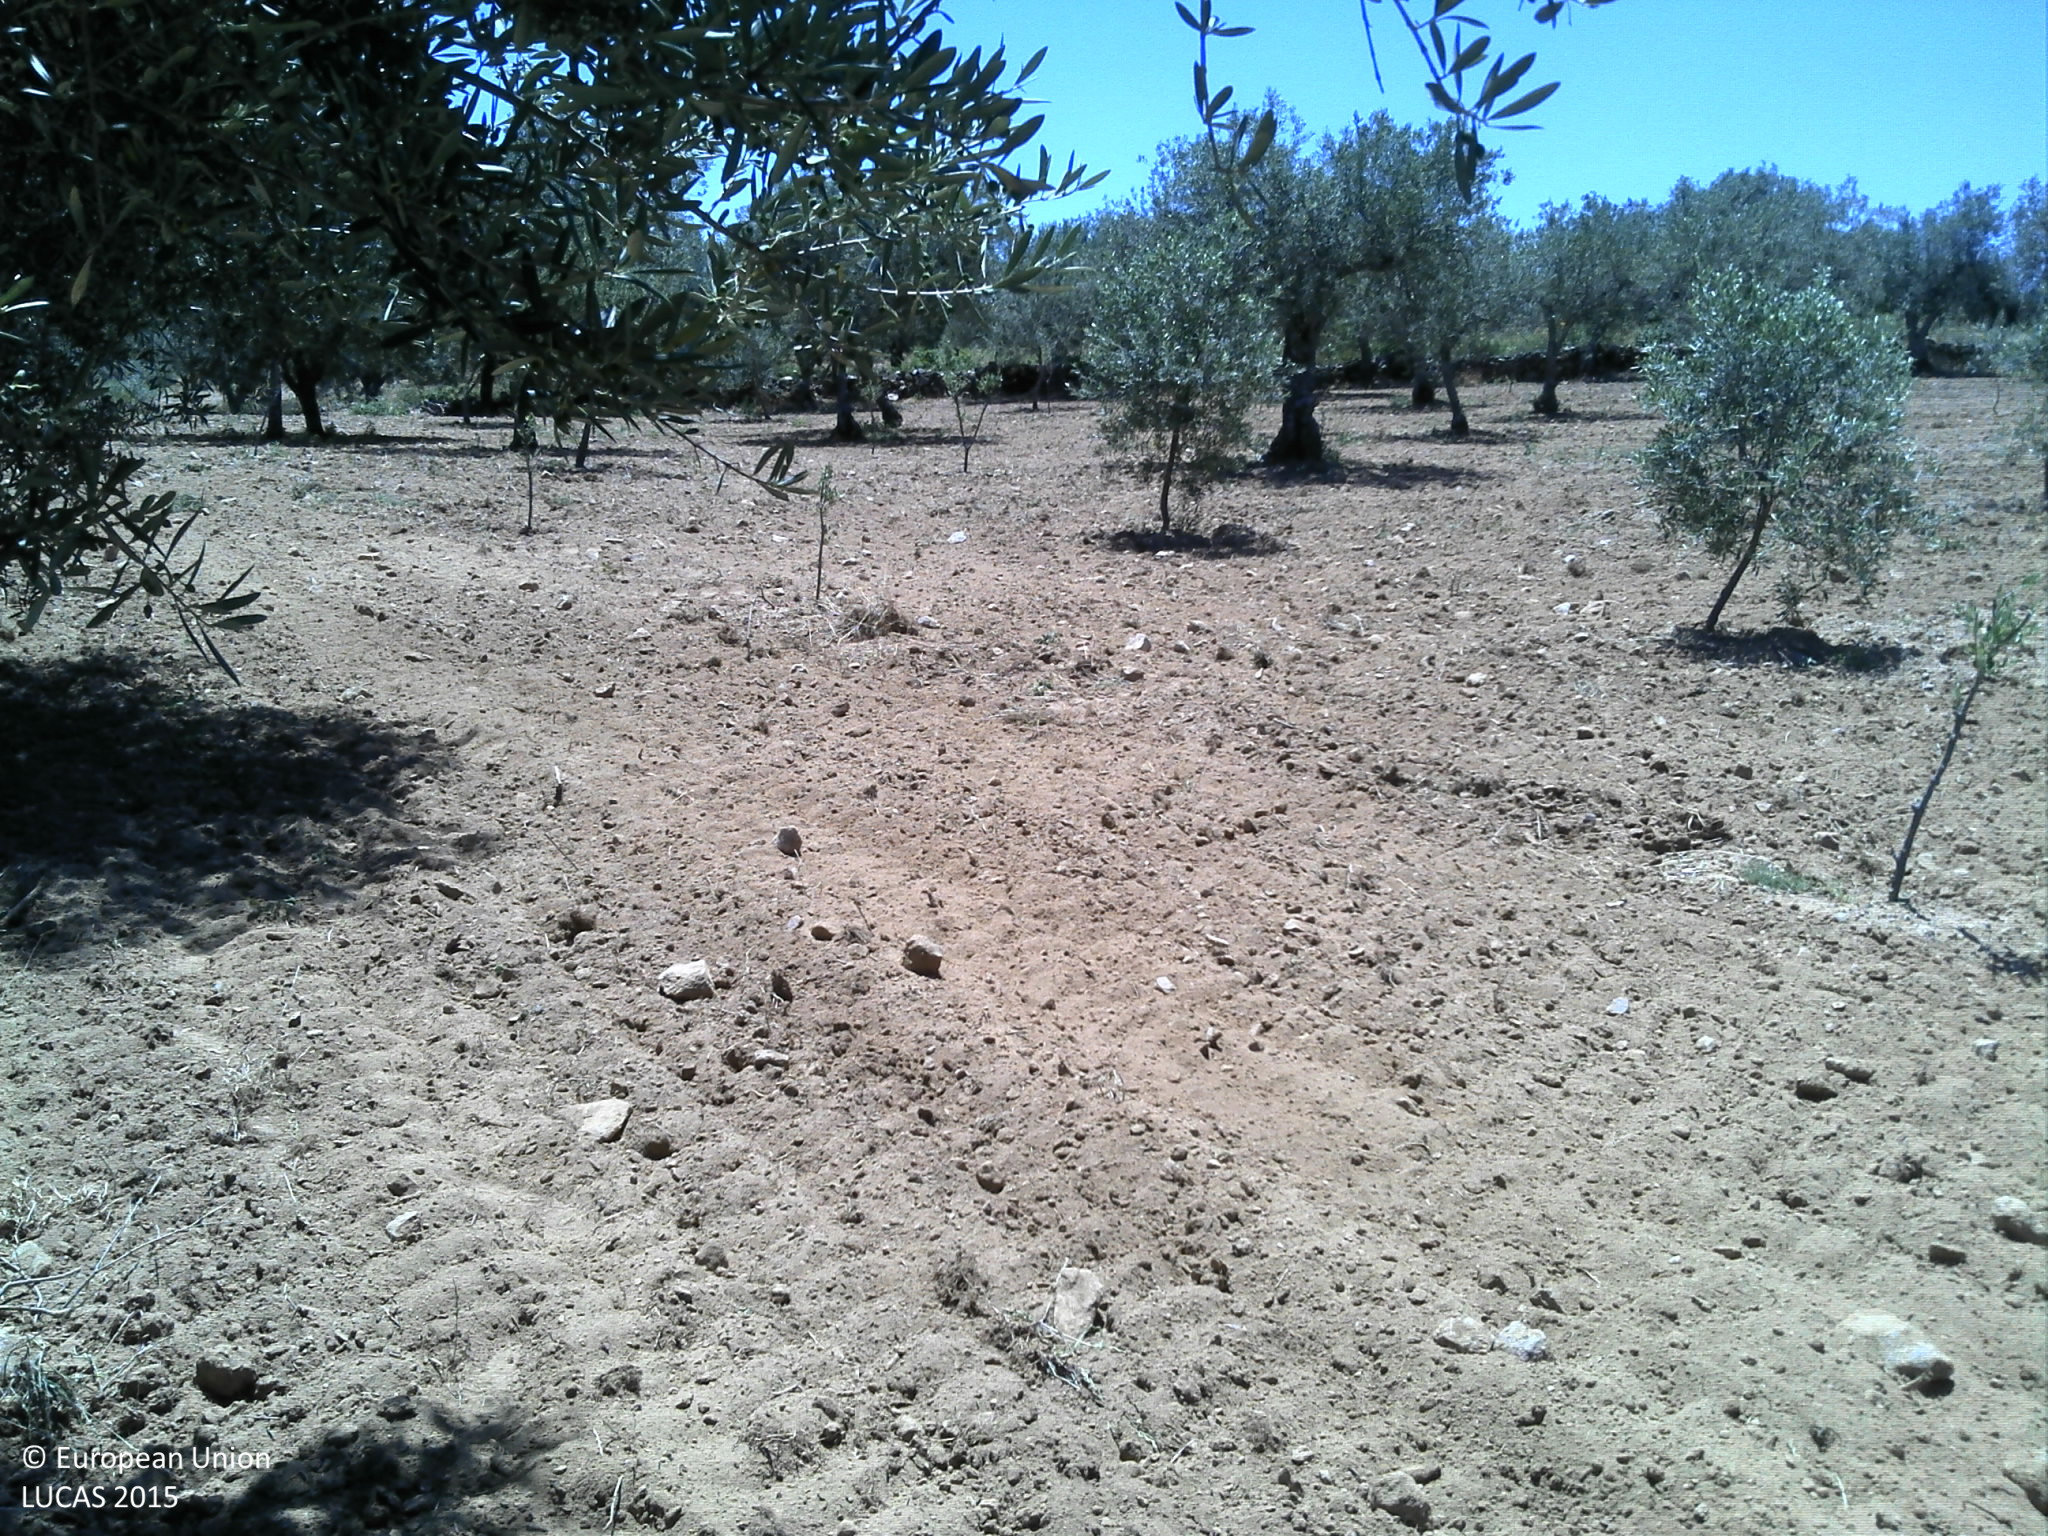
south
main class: Cropland
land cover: Olive groves
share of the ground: 25 - 50 %
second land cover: Other bare soil
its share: > 75 %
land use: Agriculture (excluding fallow land and kitchen gardens)
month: June
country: PT
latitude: 40.8041
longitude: -7.2864
